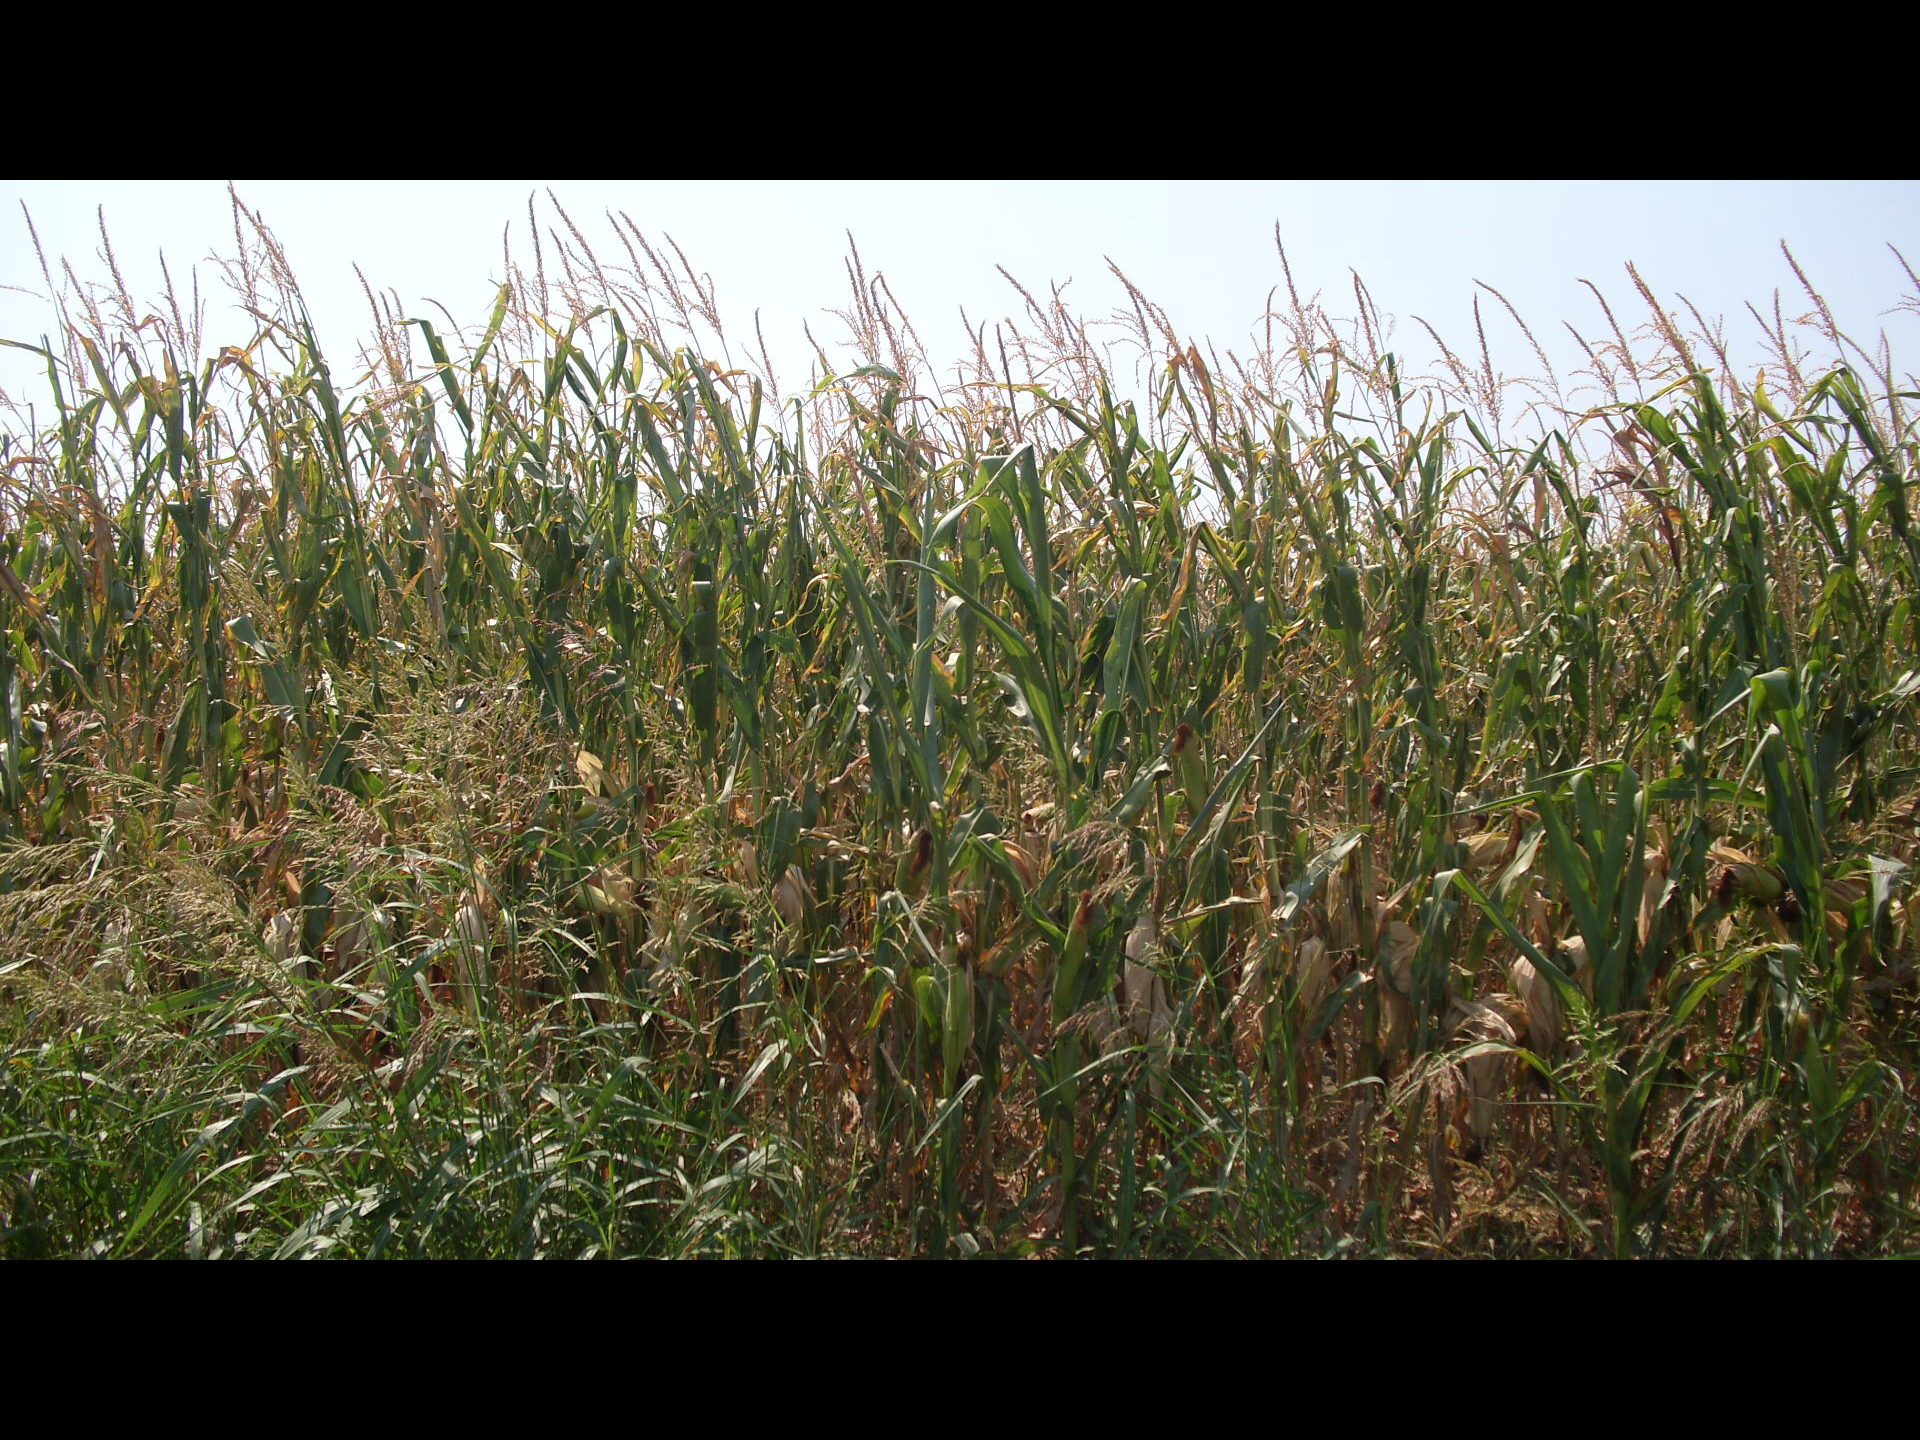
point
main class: Cropland
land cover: Maize
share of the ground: > 75 %
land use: Agriculture (excluding fallow land and kitchen gardens)
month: July
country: BG
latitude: 43.7901
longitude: 23.3797
